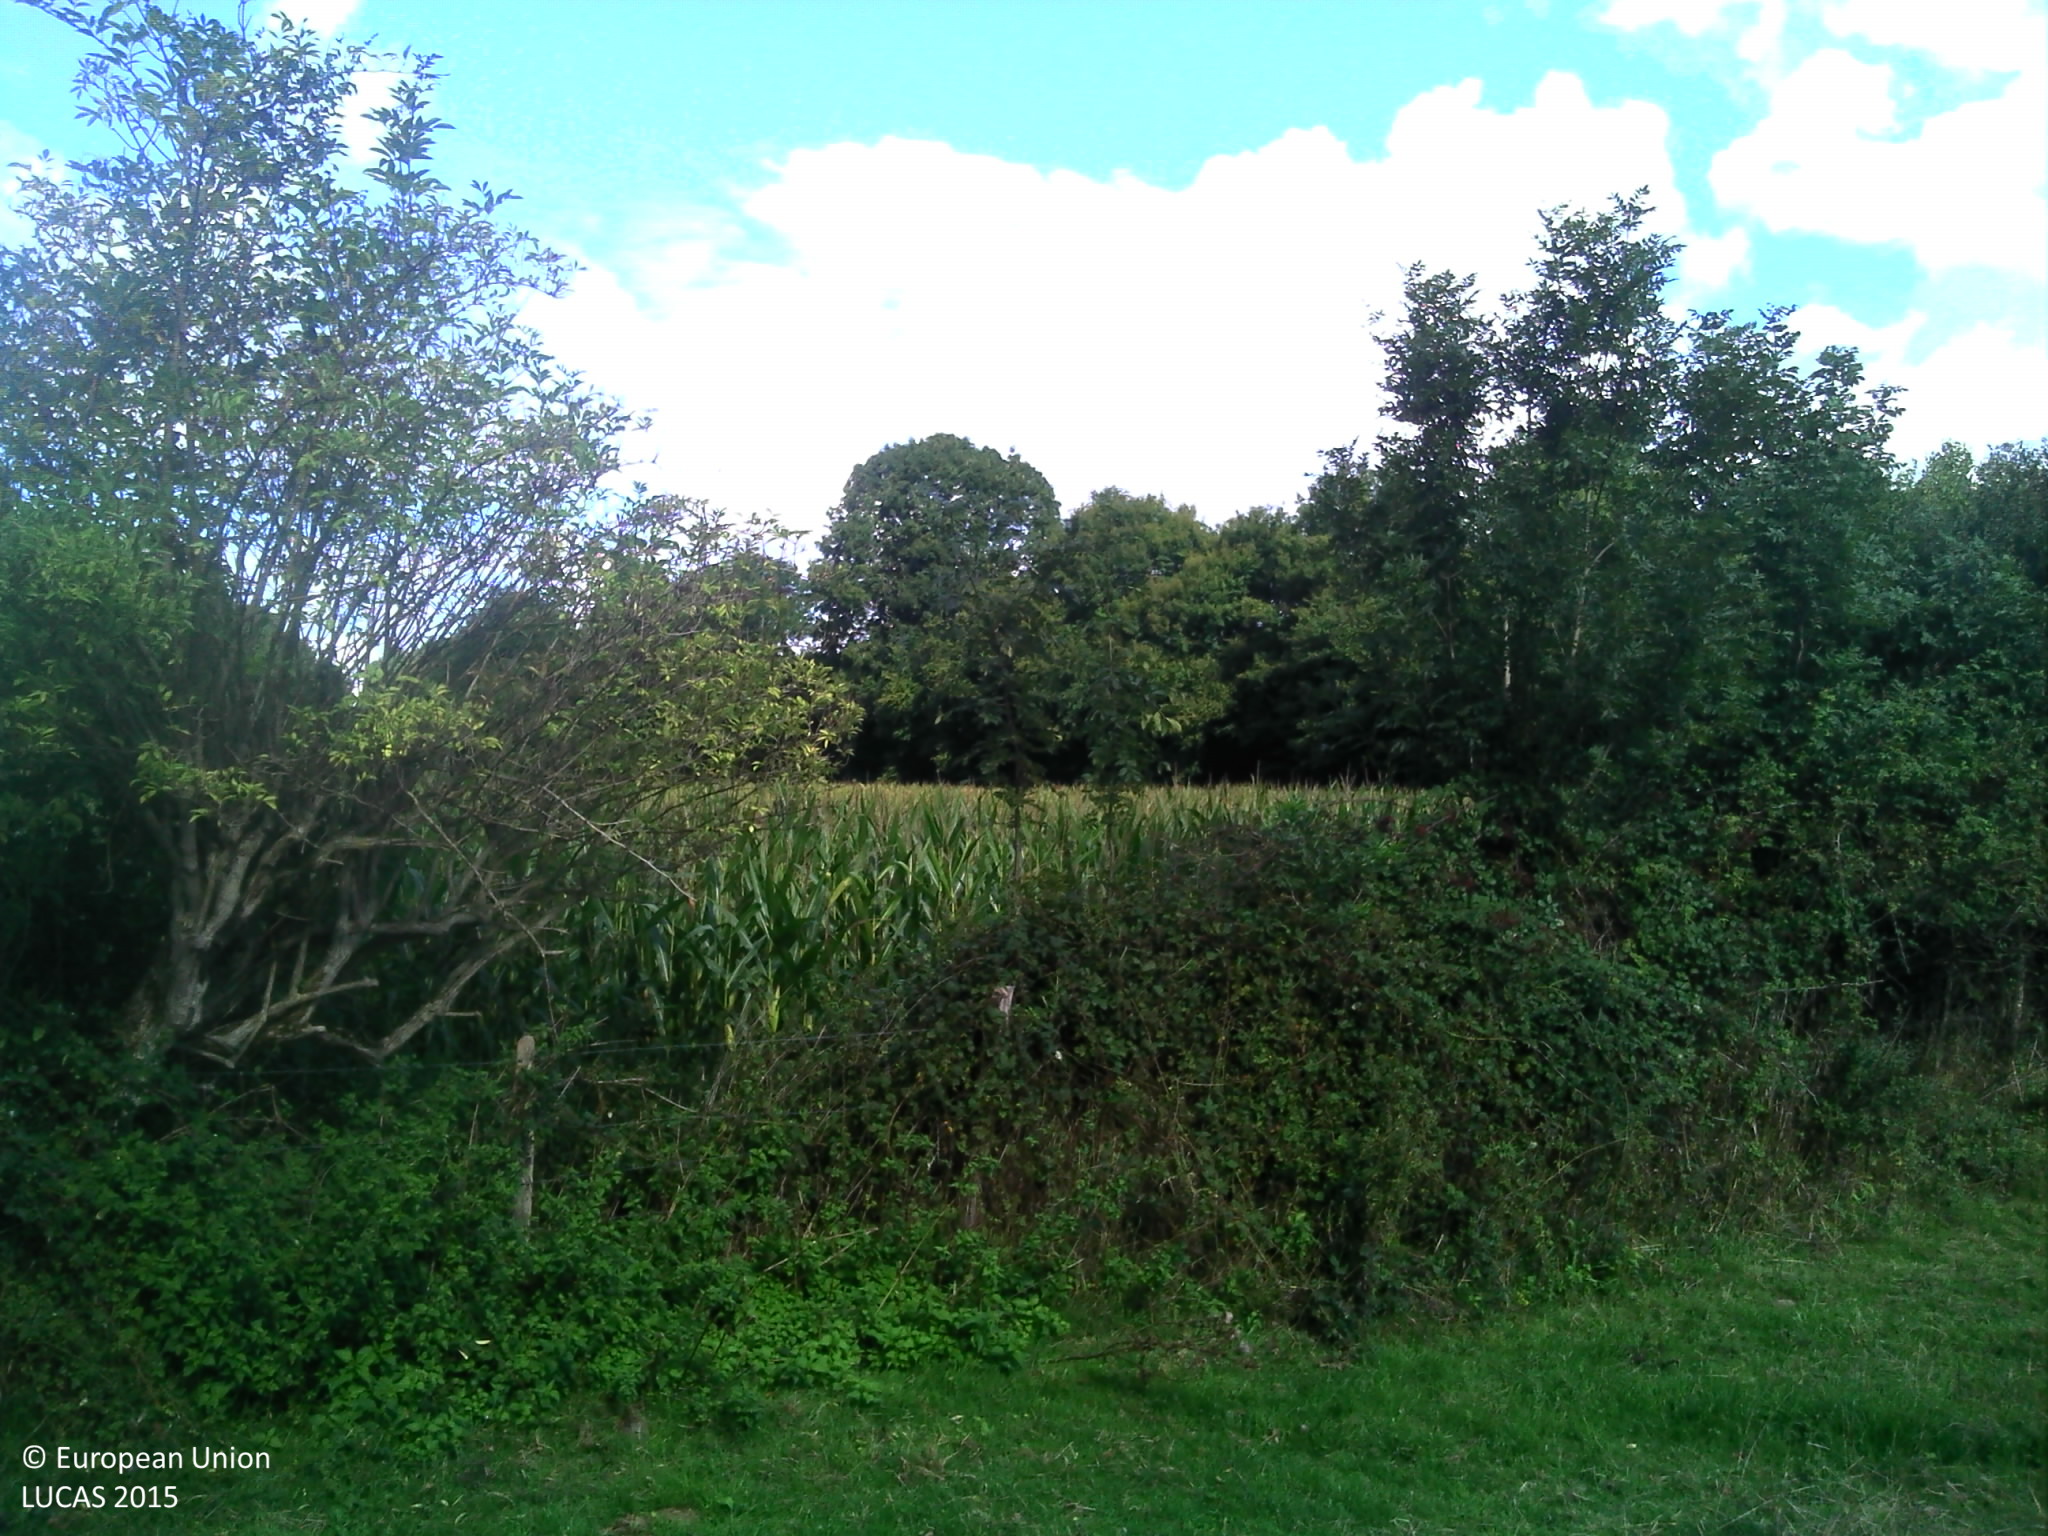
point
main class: Cropland
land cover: Maize
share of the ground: > 75 %
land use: Agriculture (excluding fallow land and kitchen gardens)
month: September
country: FR
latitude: 48.4001
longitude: 0.8067
